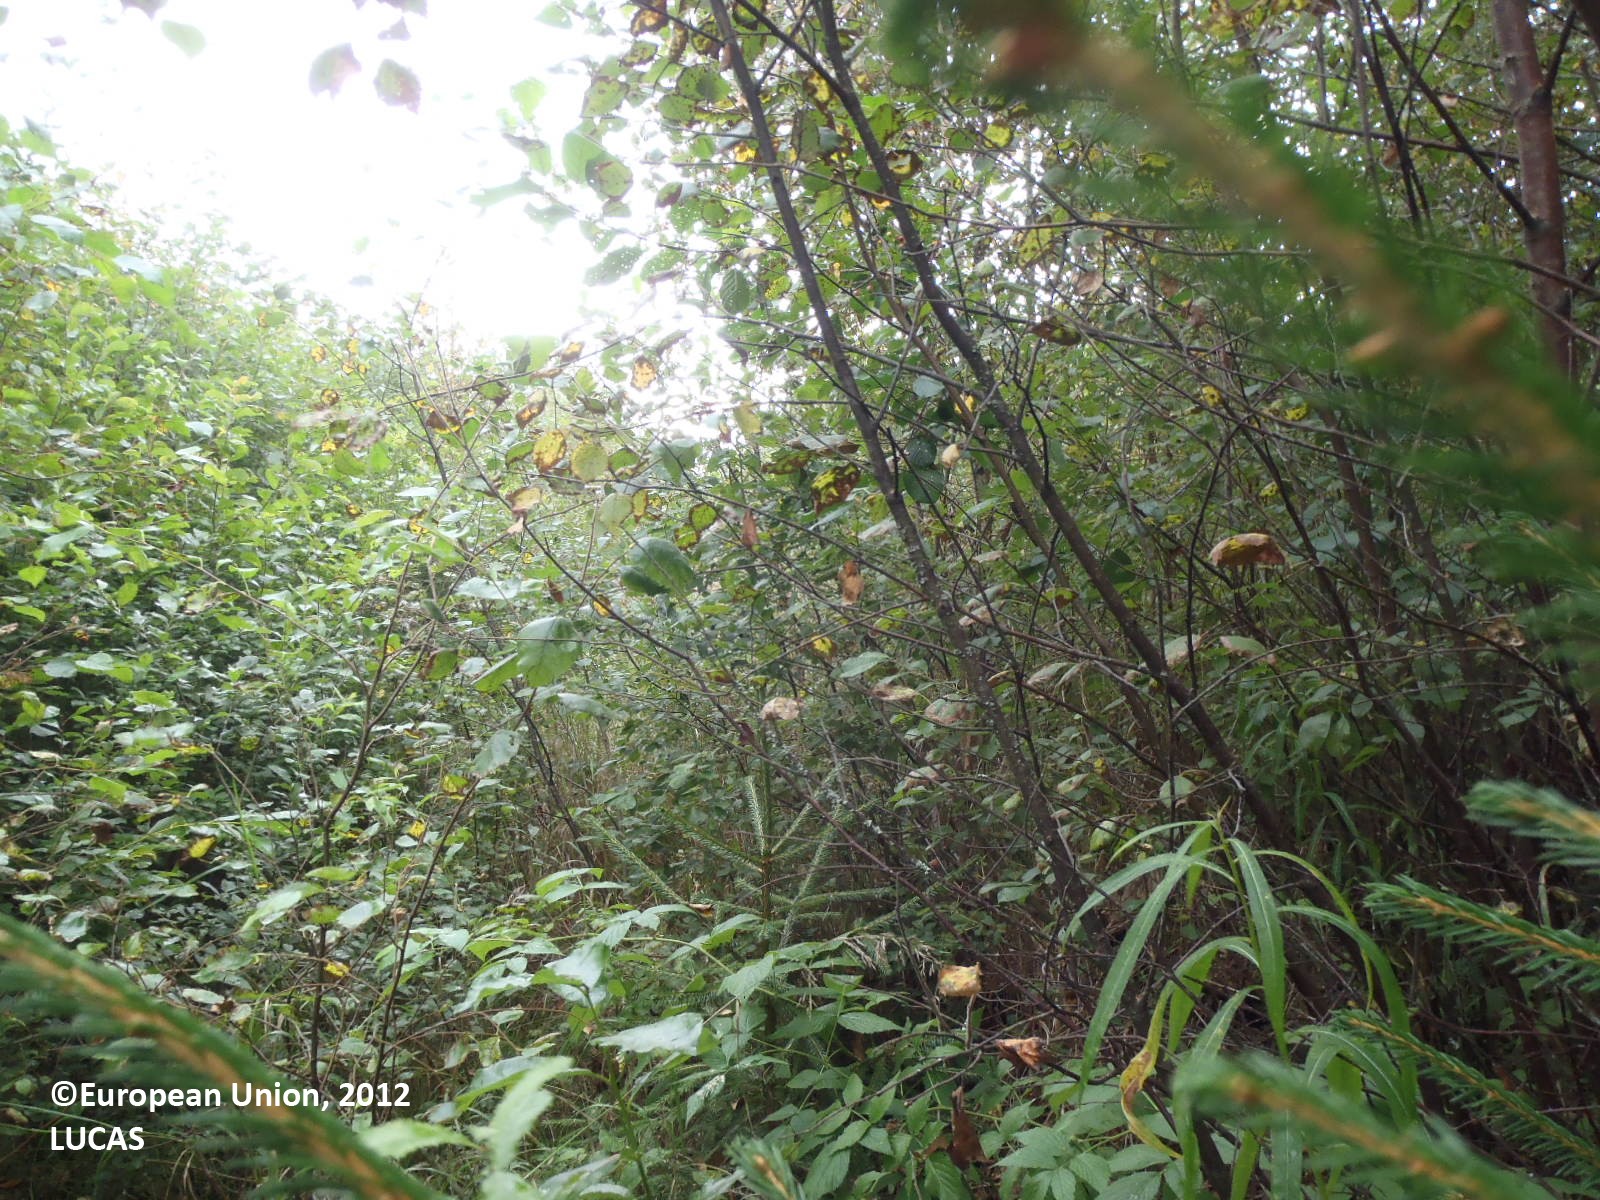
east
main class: Woodland
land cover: Broadleaved woodland
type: boreal forest
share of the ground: > 75 %
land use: Forestry
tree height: > 5 m
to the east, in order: Broadleaved woodland; Ditches and canals; Broadleaved woodland; Ditches and canals; Grass margins; Rye
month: August
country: FI
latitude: 60.5971
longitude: 22.2083
